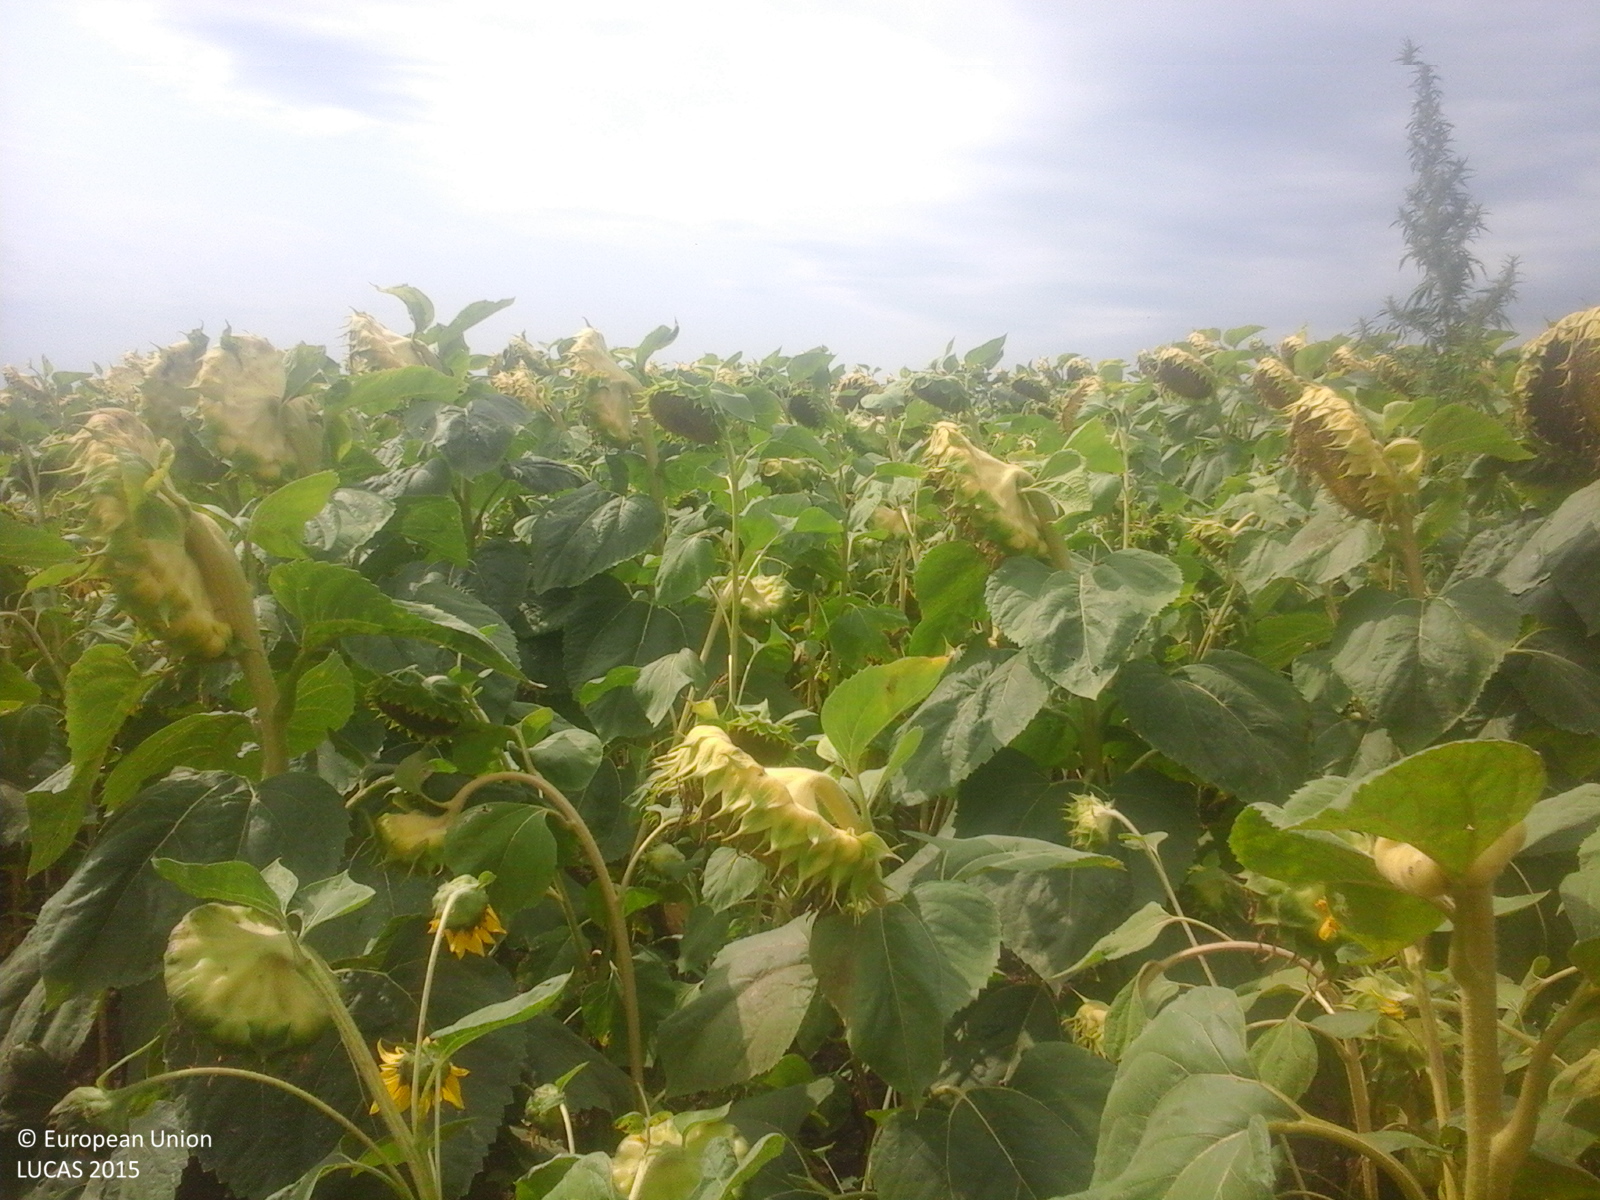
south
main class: Cropland
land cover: Sunflower
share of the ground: > 75 %
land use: Agriculture (excluding fallow land and kitchen gardens)
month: August
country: RO
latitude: 43.9231
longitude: 28.2042
